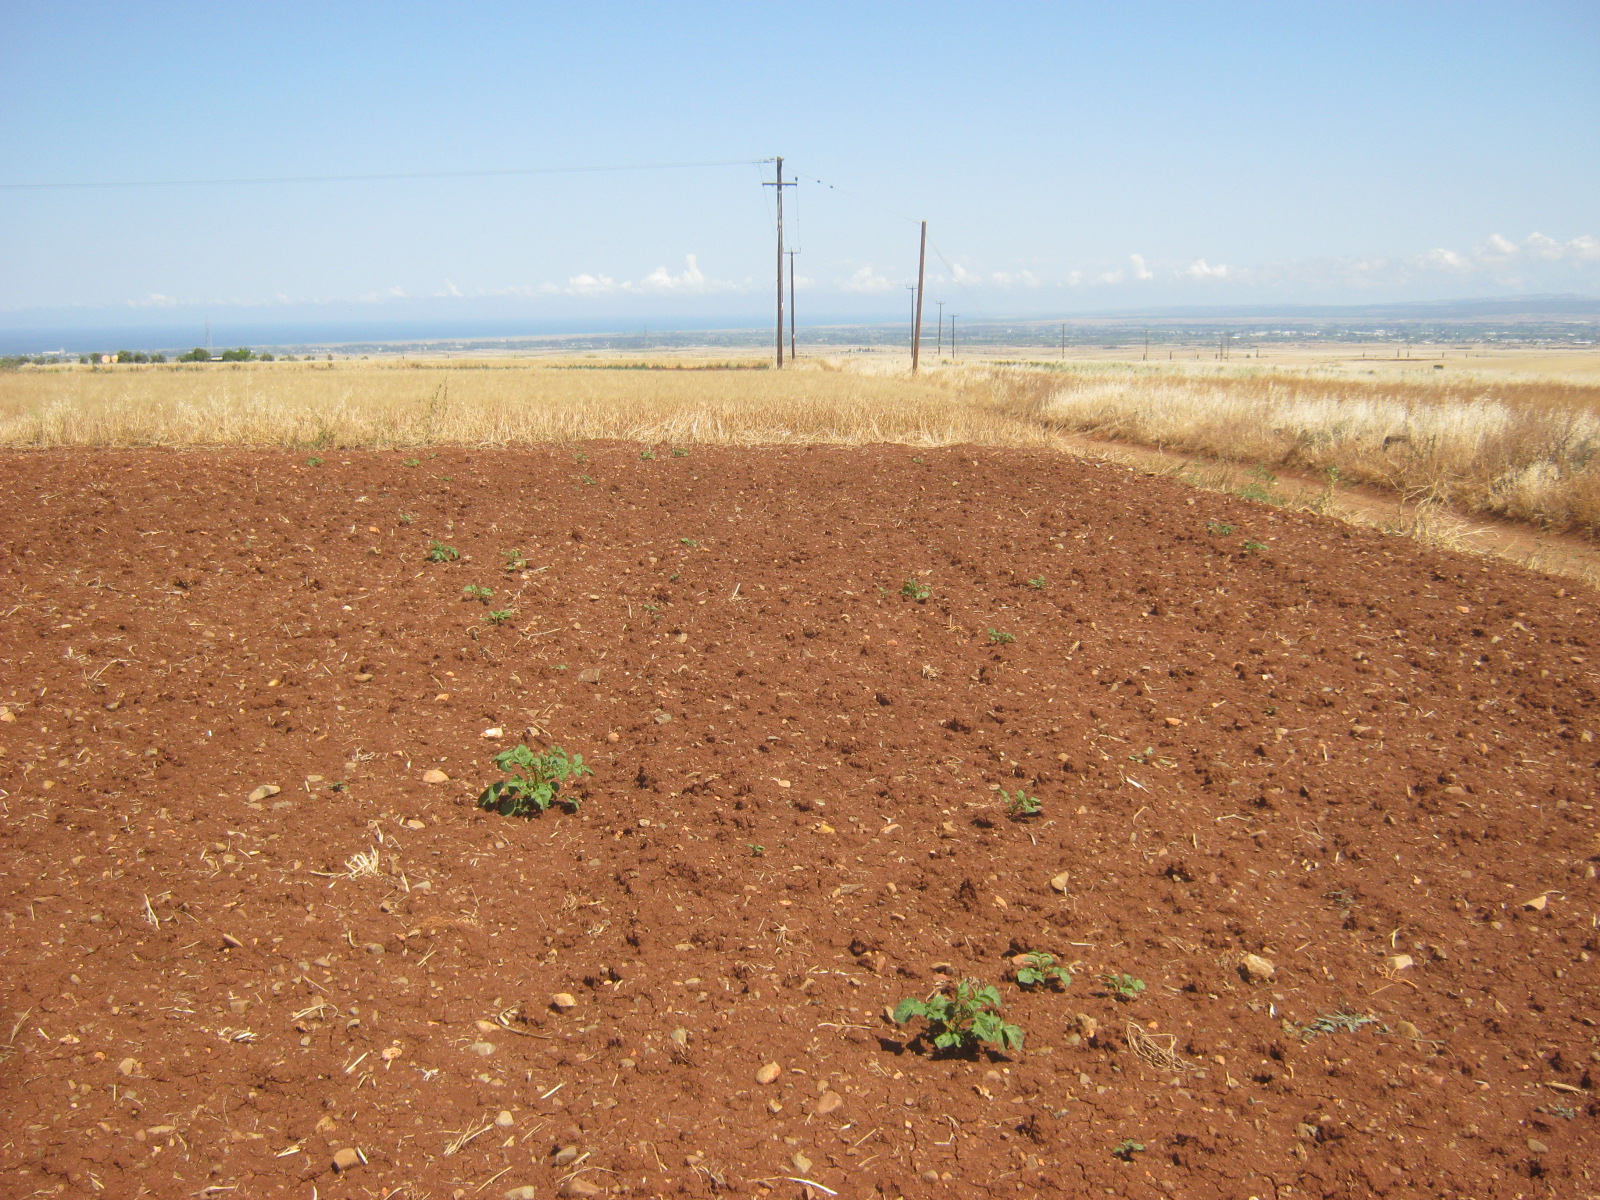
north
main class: Cropland
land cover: Potatoes
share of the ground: < 10 %
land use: Agriculture (excluding fallow land and kitchen gardens)
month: May
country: CY
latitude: 35.0930
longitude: 33.0040
